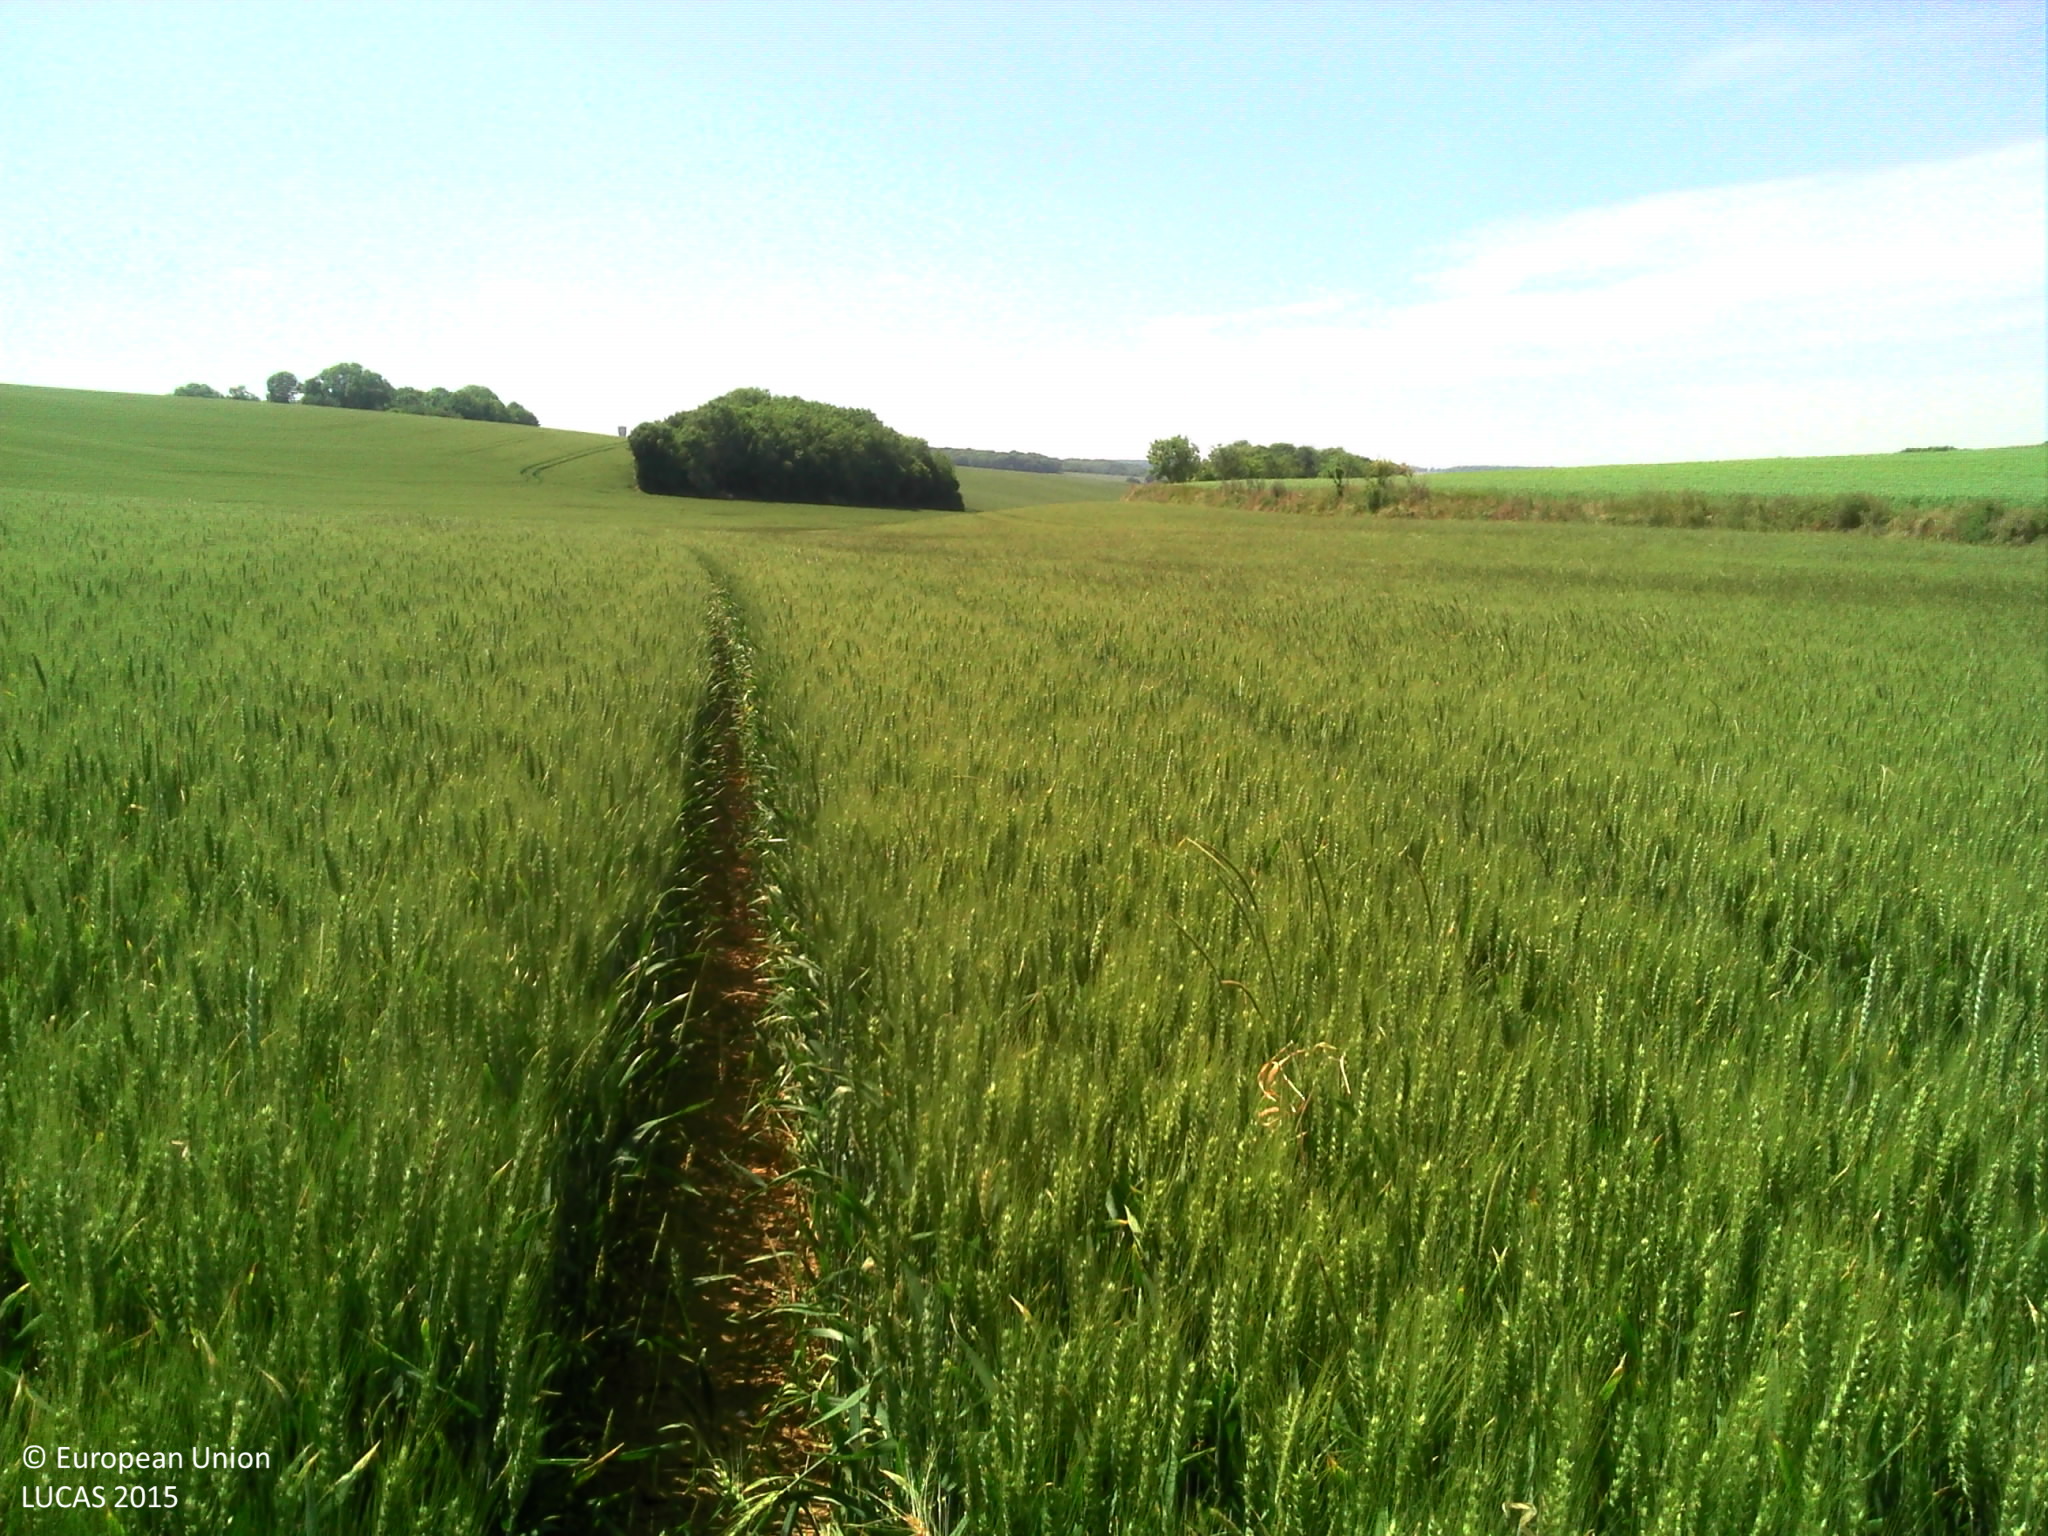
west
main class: Cropland
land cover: Common wheat
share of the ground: > 75 %
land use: Agriculture (excluding fallow land and kitchen gardens)
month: June
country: FR
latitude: 49.7118
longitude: 2.3735
